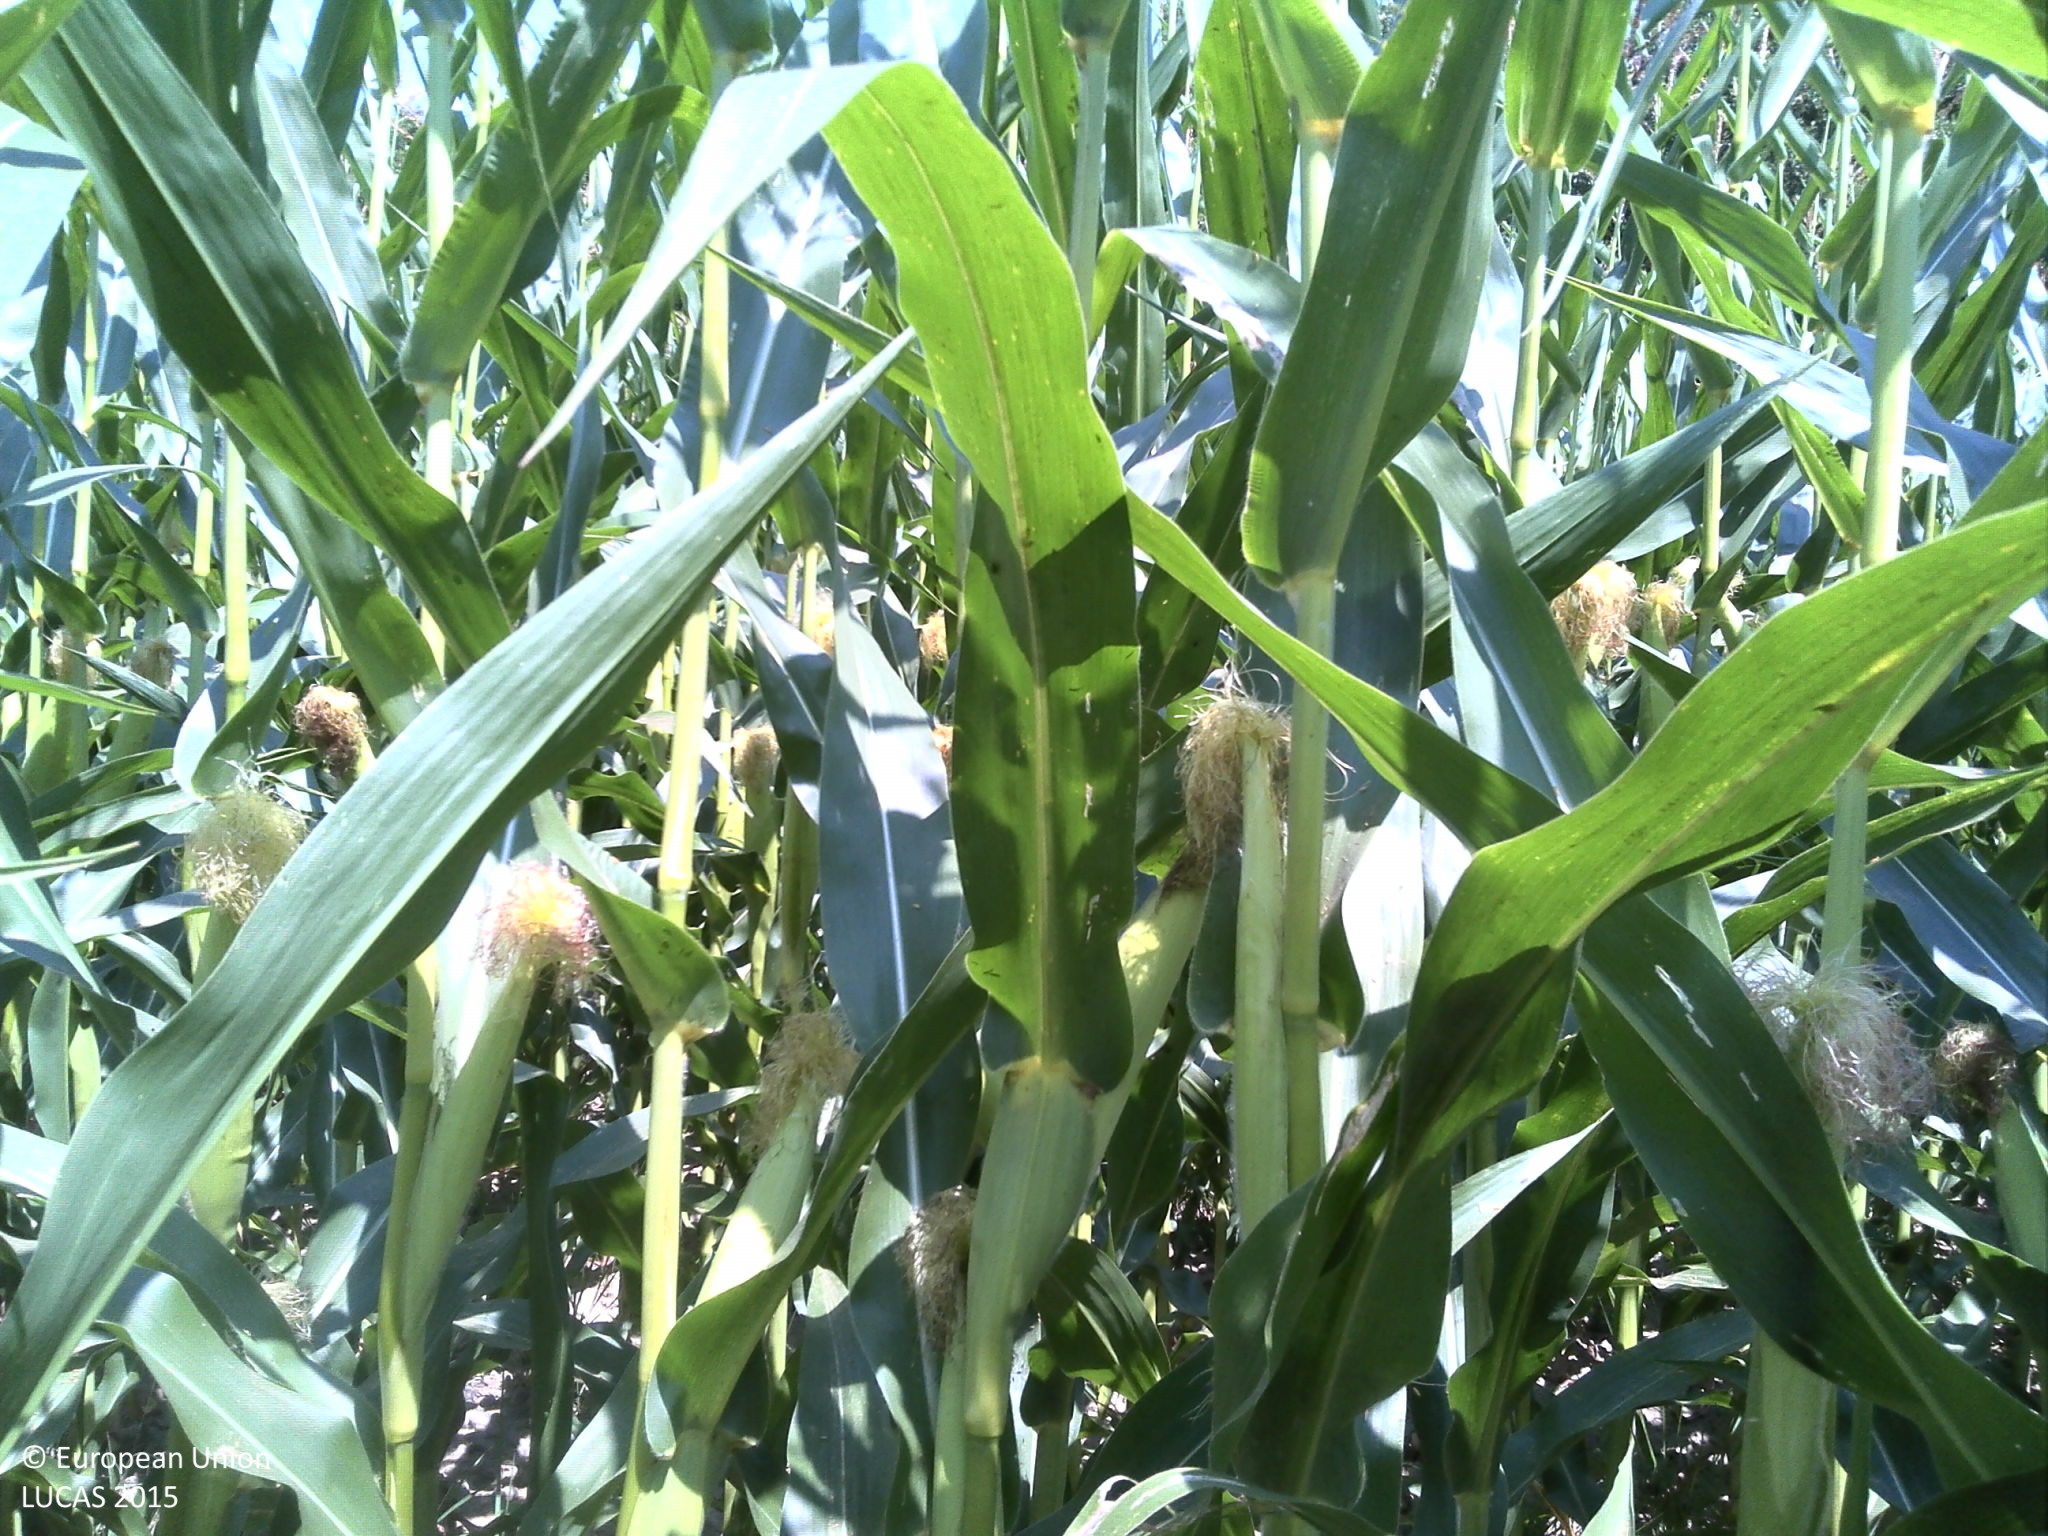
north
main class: Cropland
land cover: Maize
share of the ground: > 75 %
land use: Agriculture (excluding fallow land and kitchen gardens)
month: July
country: HR
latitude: 45.8660
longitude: 16.7628
